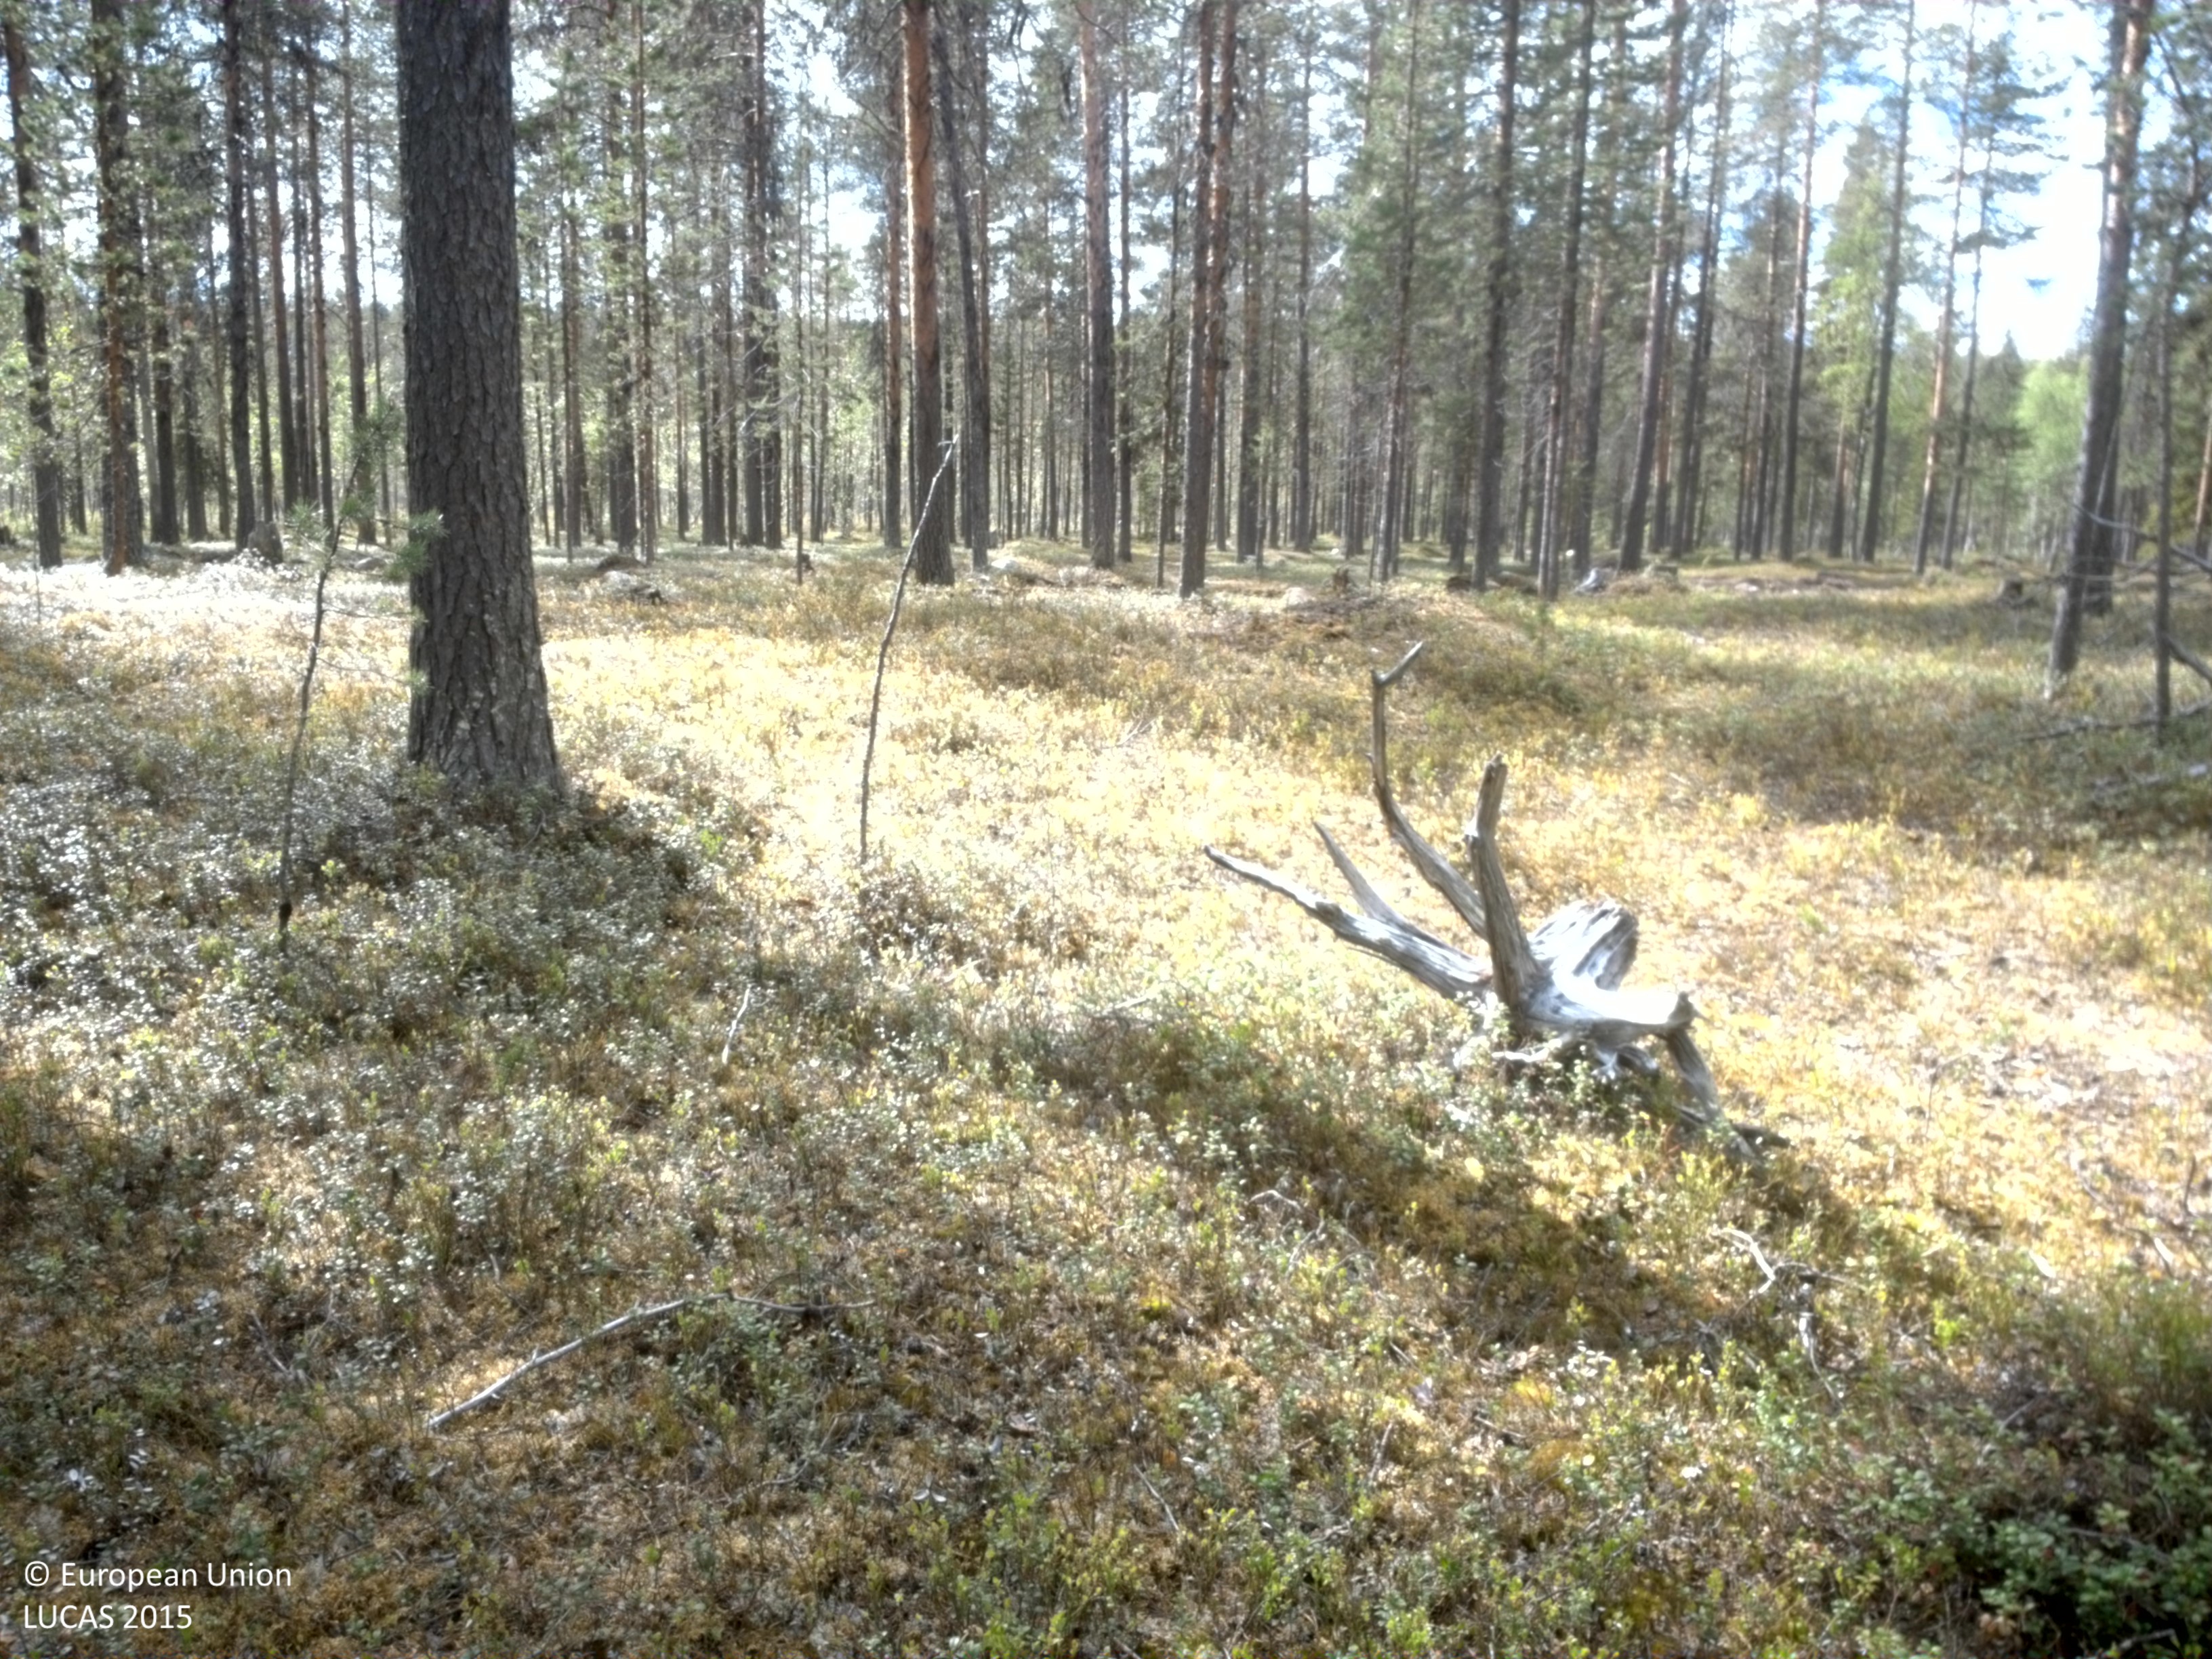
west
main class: Woodland
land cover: Pine dominated coniferous woodland
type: boreal forest
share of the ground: 25 - 50 %
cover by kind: shrubs 65 %, coniferous forest trees 25 %, lichens and mosses 10 %
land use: Forestry
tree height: > 5 m
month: June
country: SE
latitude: 66.8967
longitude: 21.9510
